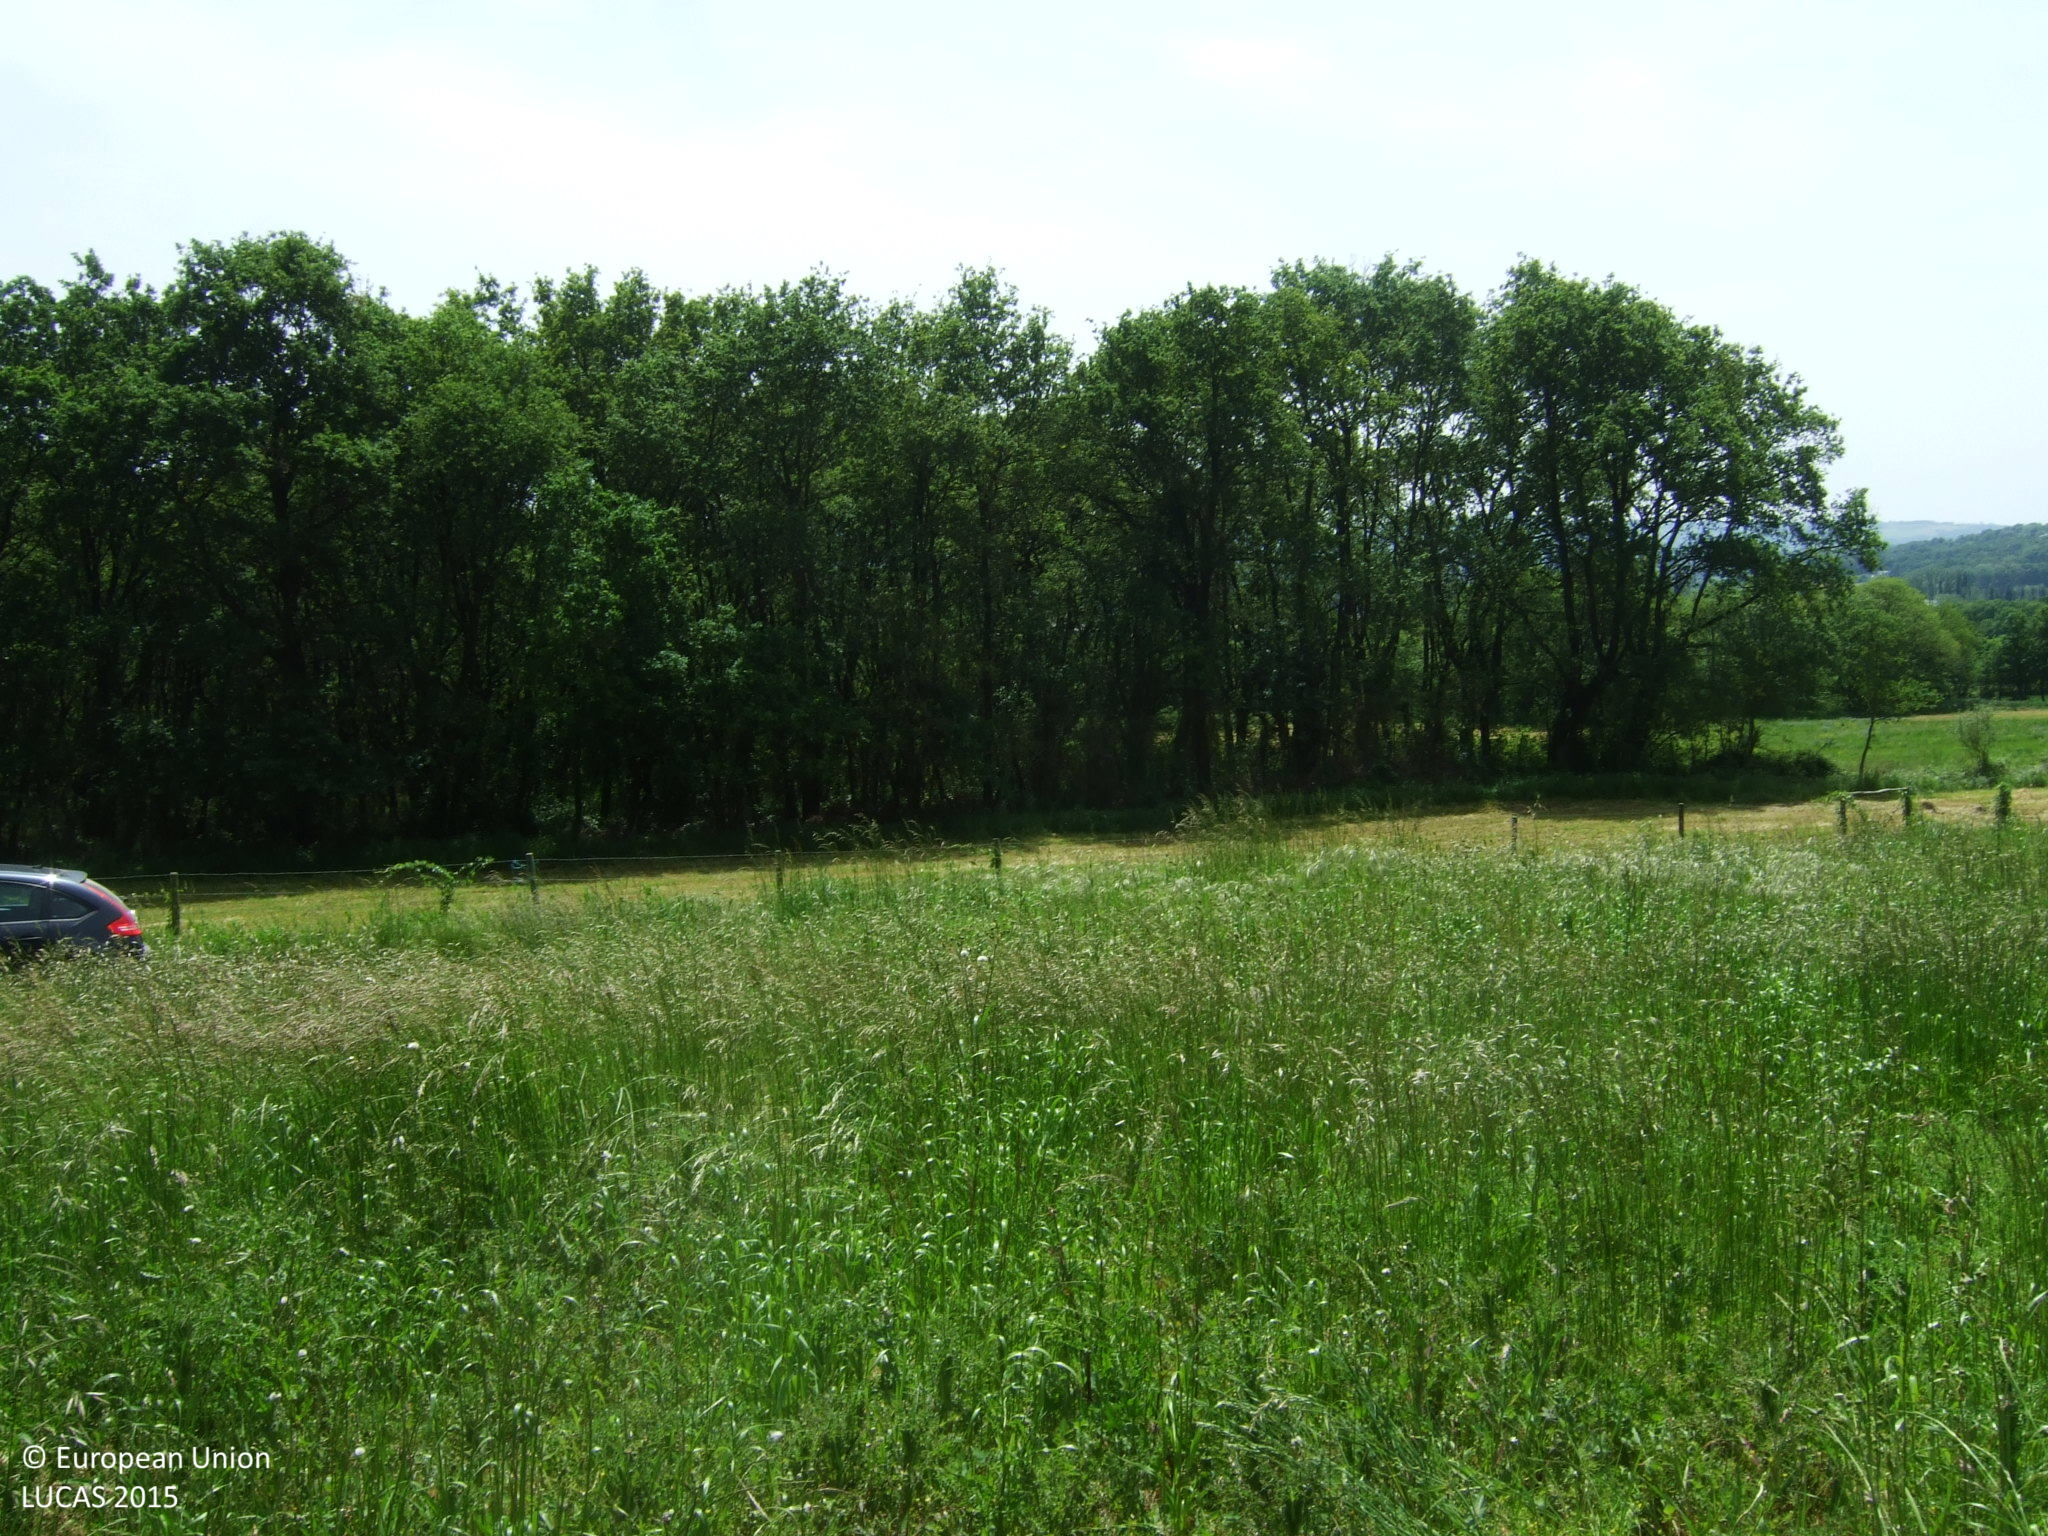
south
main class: Grassland
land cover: Grassland without tree/shrub cover
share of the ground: > 75 %
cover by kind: herbaceous plants 100 %
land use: Agriculture (excluding fallow land and kitchen gardens)
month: May
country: ES
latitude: 42.8506
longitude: -7.3861
